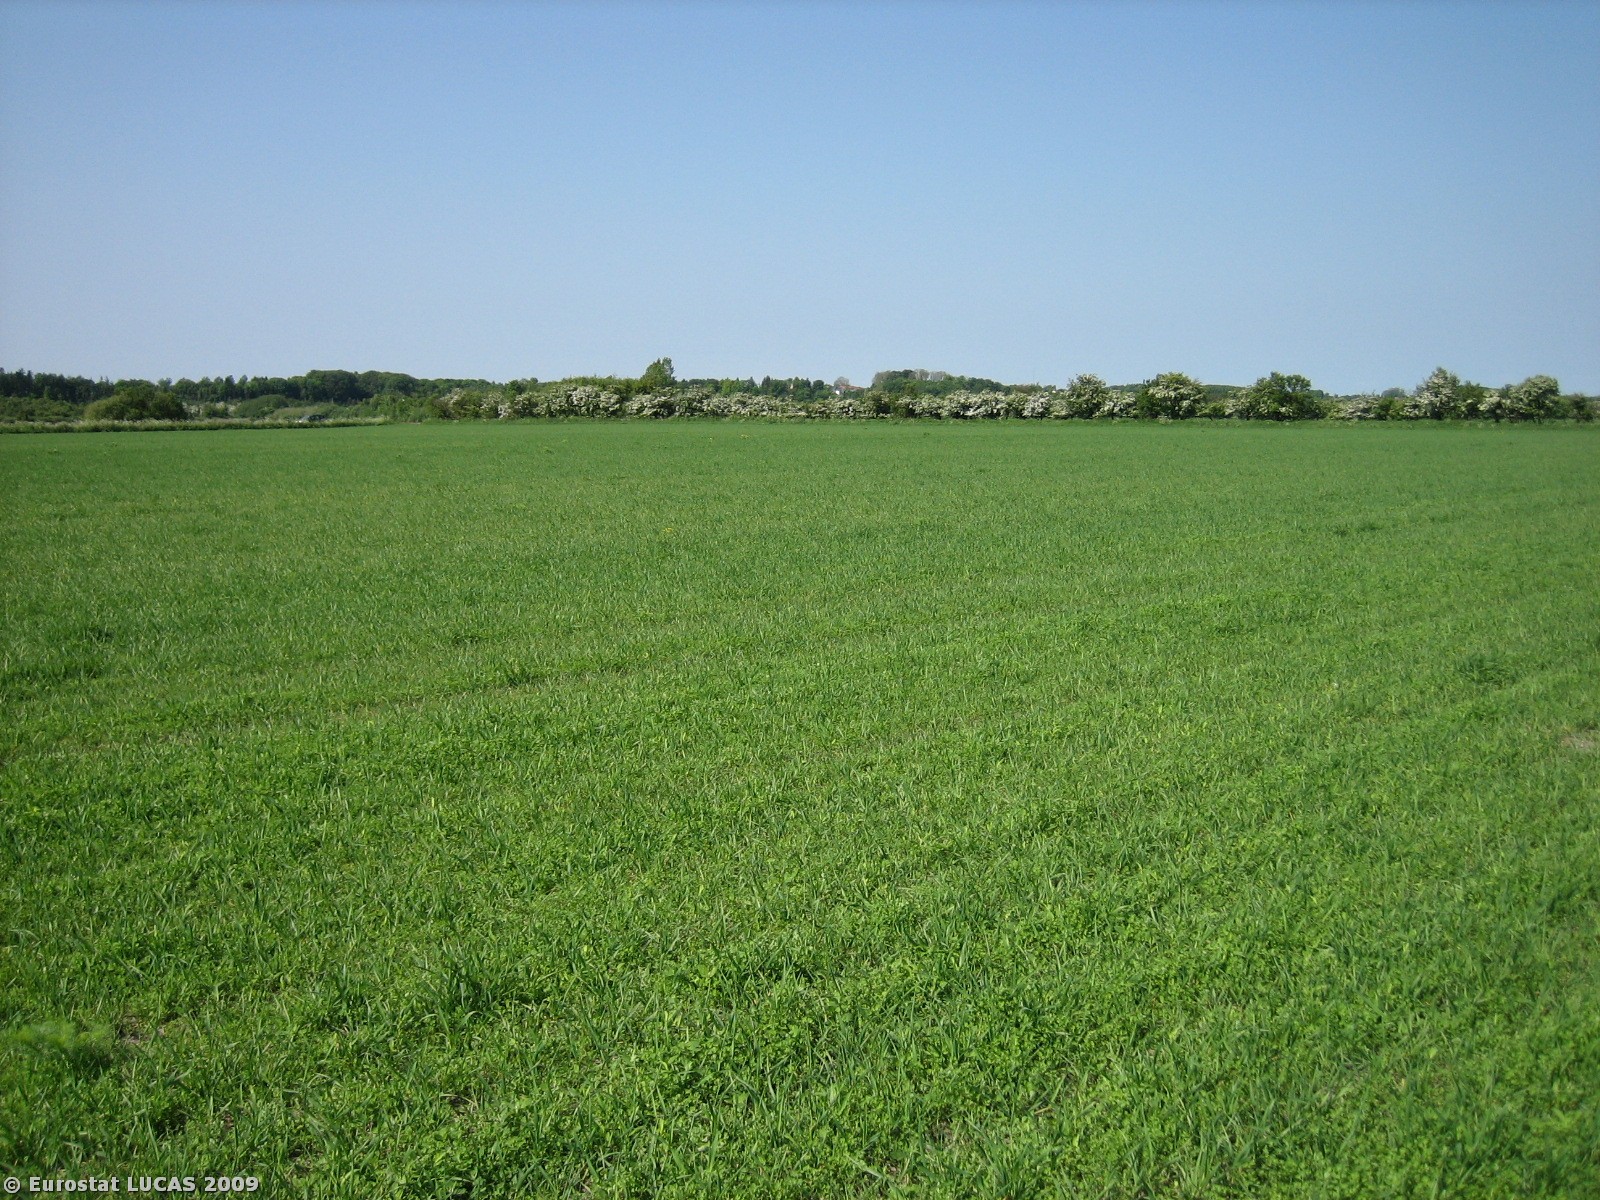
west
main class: Cropland
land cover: Barley
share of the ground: 50 - 75 %
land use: Agriculture (excluding fallow land and kitchen gardens)
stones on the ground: < 10 %
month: May
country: DK
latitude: 56.1314
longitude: 9.2125
